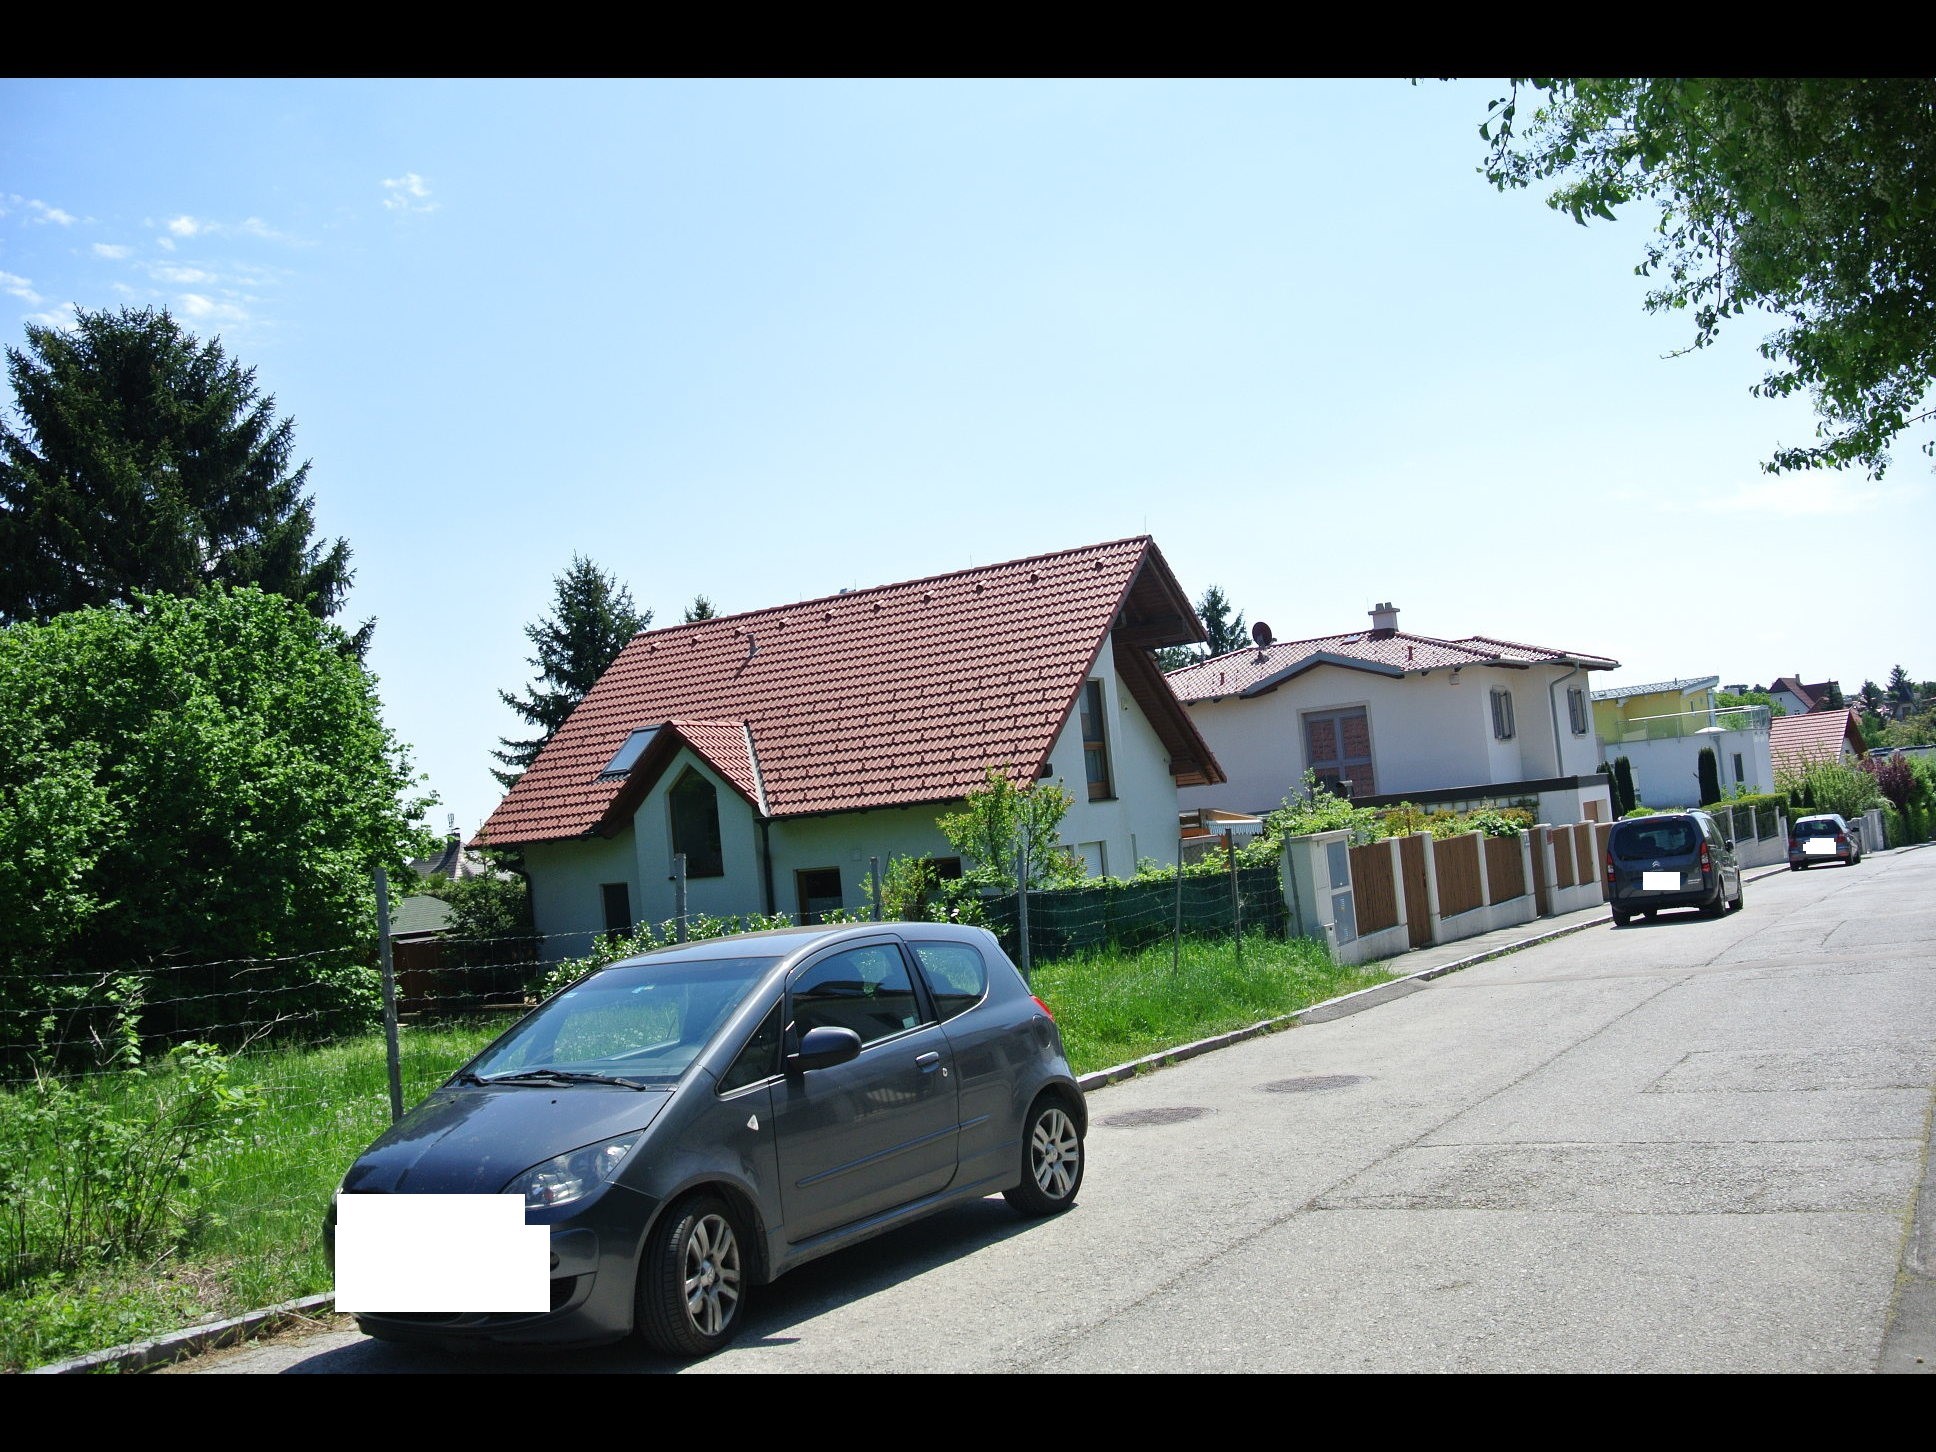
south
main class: Grassland
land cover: Grassland with sparse tree/shrub cover
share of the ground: > 75 %
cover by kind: herbaceous plants 85 %, shrubs 10 %, broadleaved forest trees 5 %
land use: Residential
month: May
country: AT
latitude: 48.1183
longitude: 16.2508
